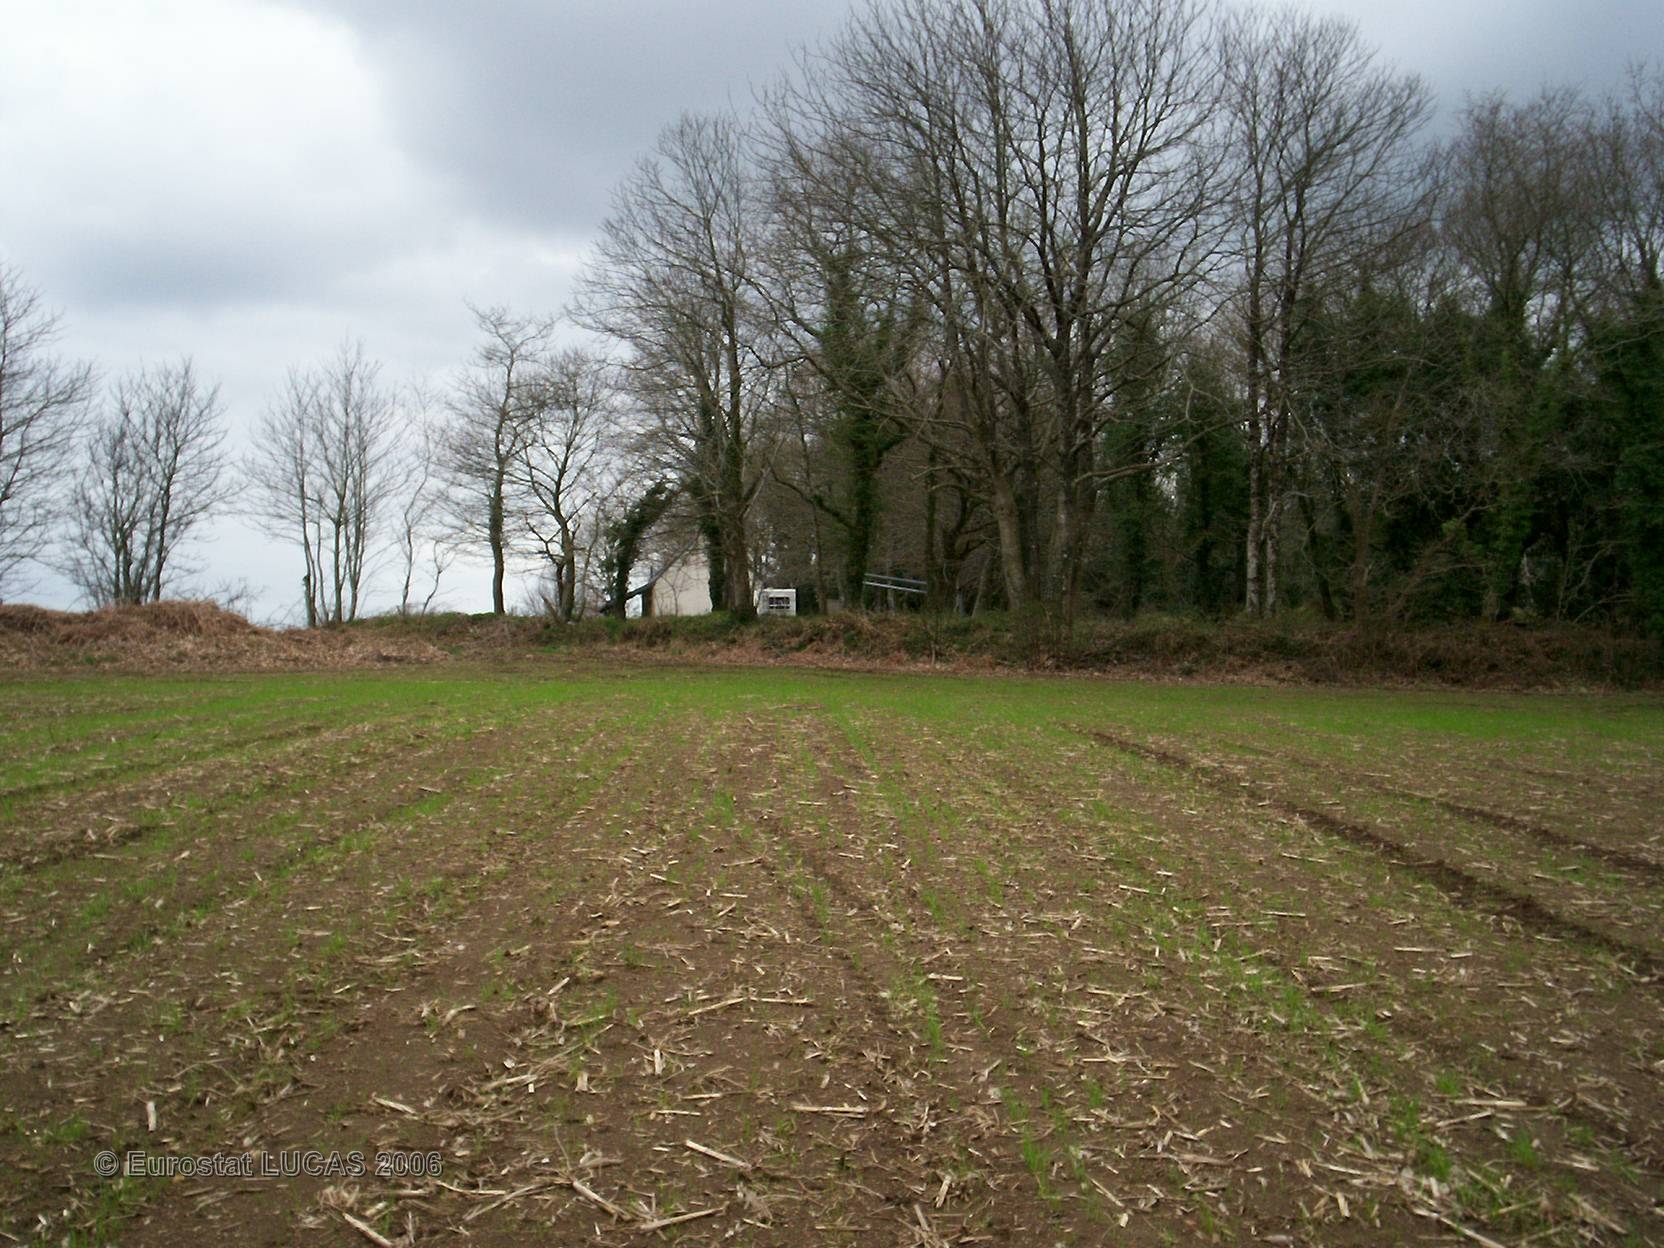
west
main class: Grassland
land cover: Grassland without tree/shrub cover
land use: Agriculture (excluding fallow land and kitchen gardens)
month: April
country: FR
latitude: 47.9674
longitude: -3.5383
